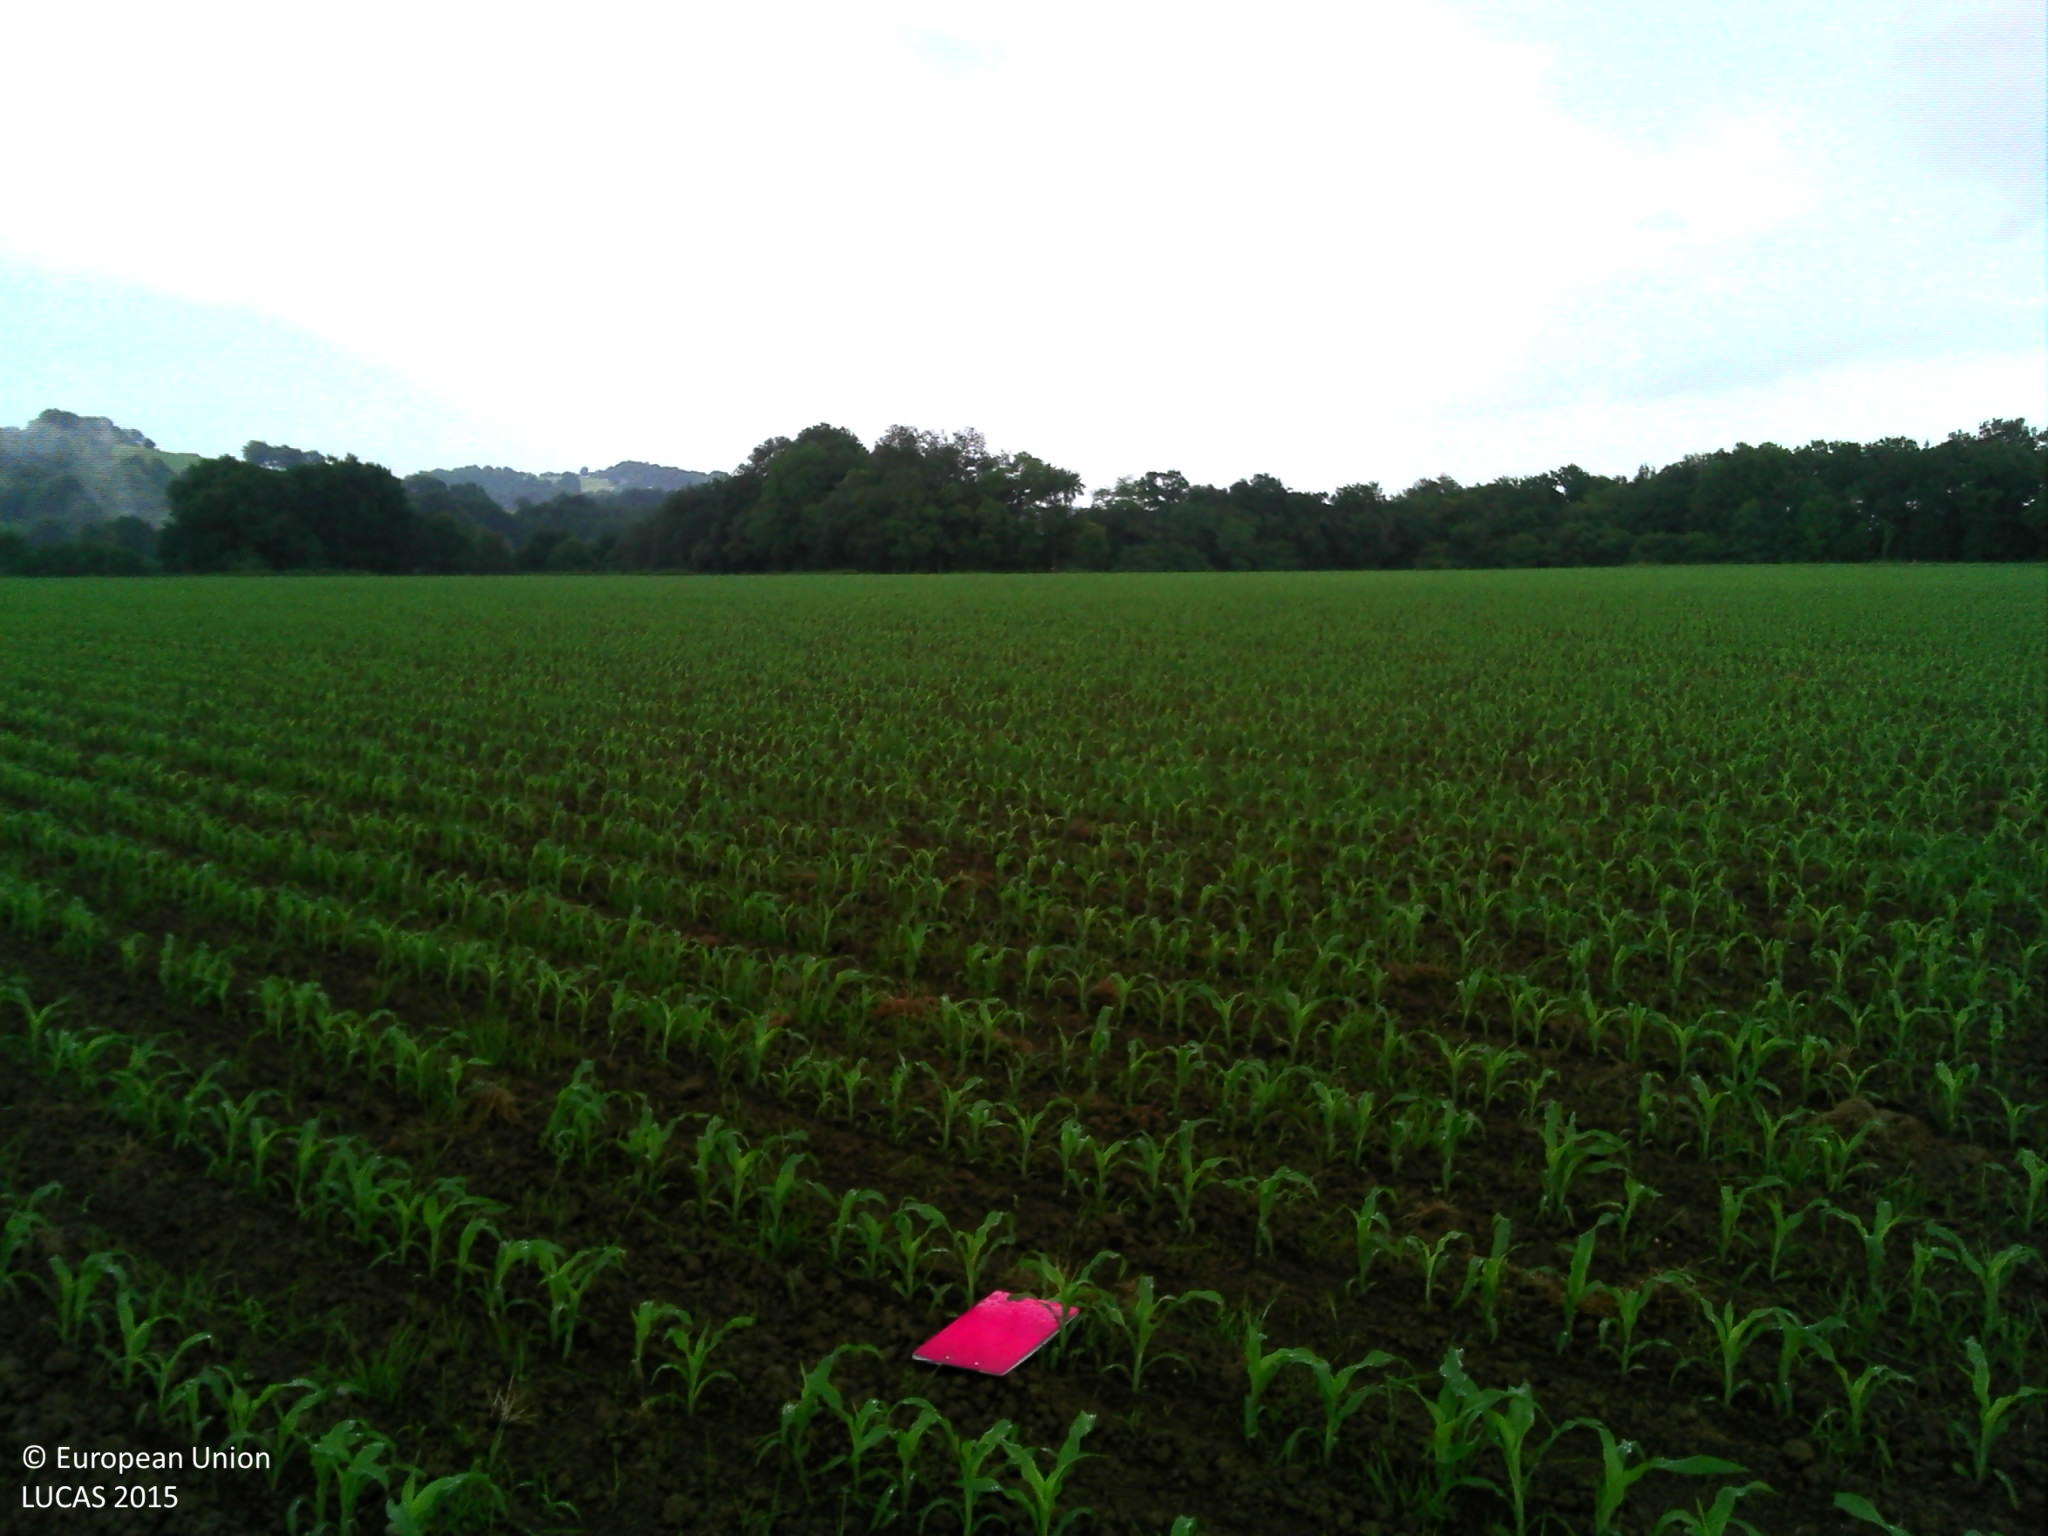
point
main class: Cropland
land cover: Maize
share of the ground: 10 - 25 %
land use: Agriculture (excluding fallow land and kitchen gardens)
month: June
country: FR
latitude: 43.2387
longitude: -0.6359
